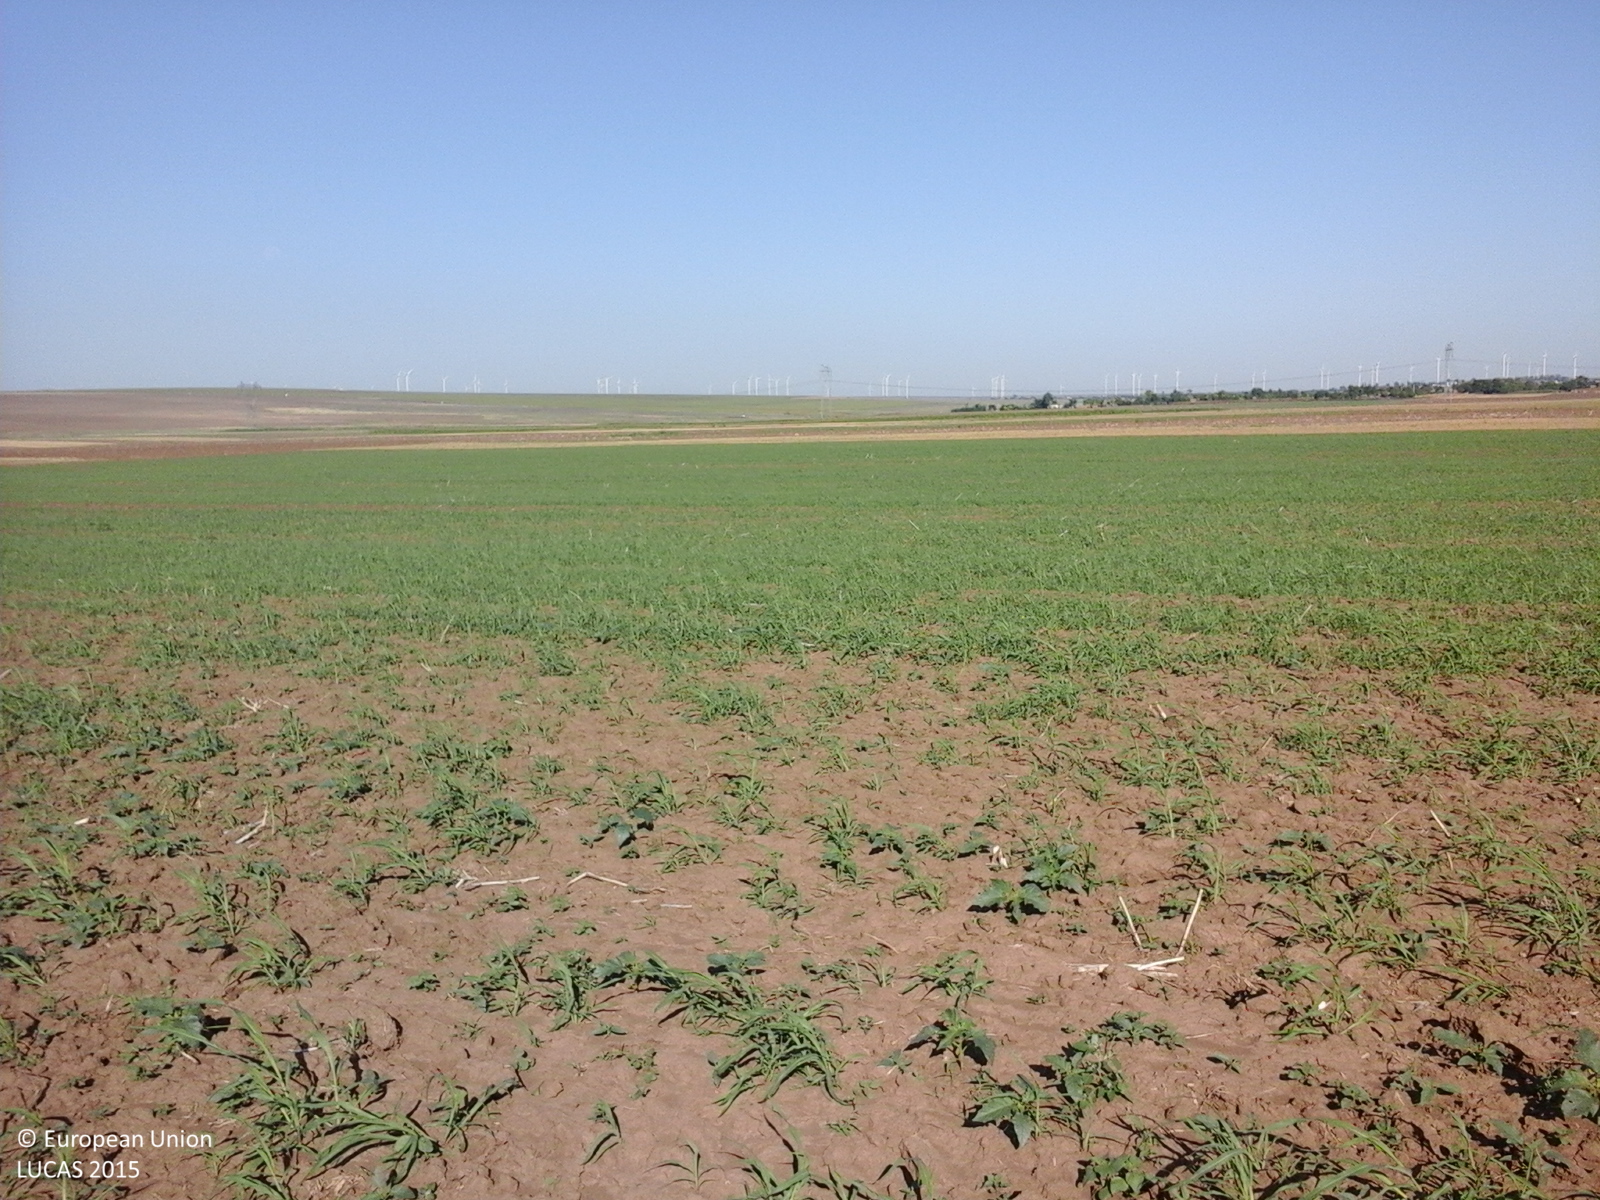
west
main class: Grassland
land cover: Spontaneously vegetated surfaces
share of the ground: > 75 %
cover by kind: herbaceous plants 100 %
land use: Agriculture (excluding fallow land and kitchen gardens)
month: August
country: RO
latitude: 44.5496
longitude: 28.6192
